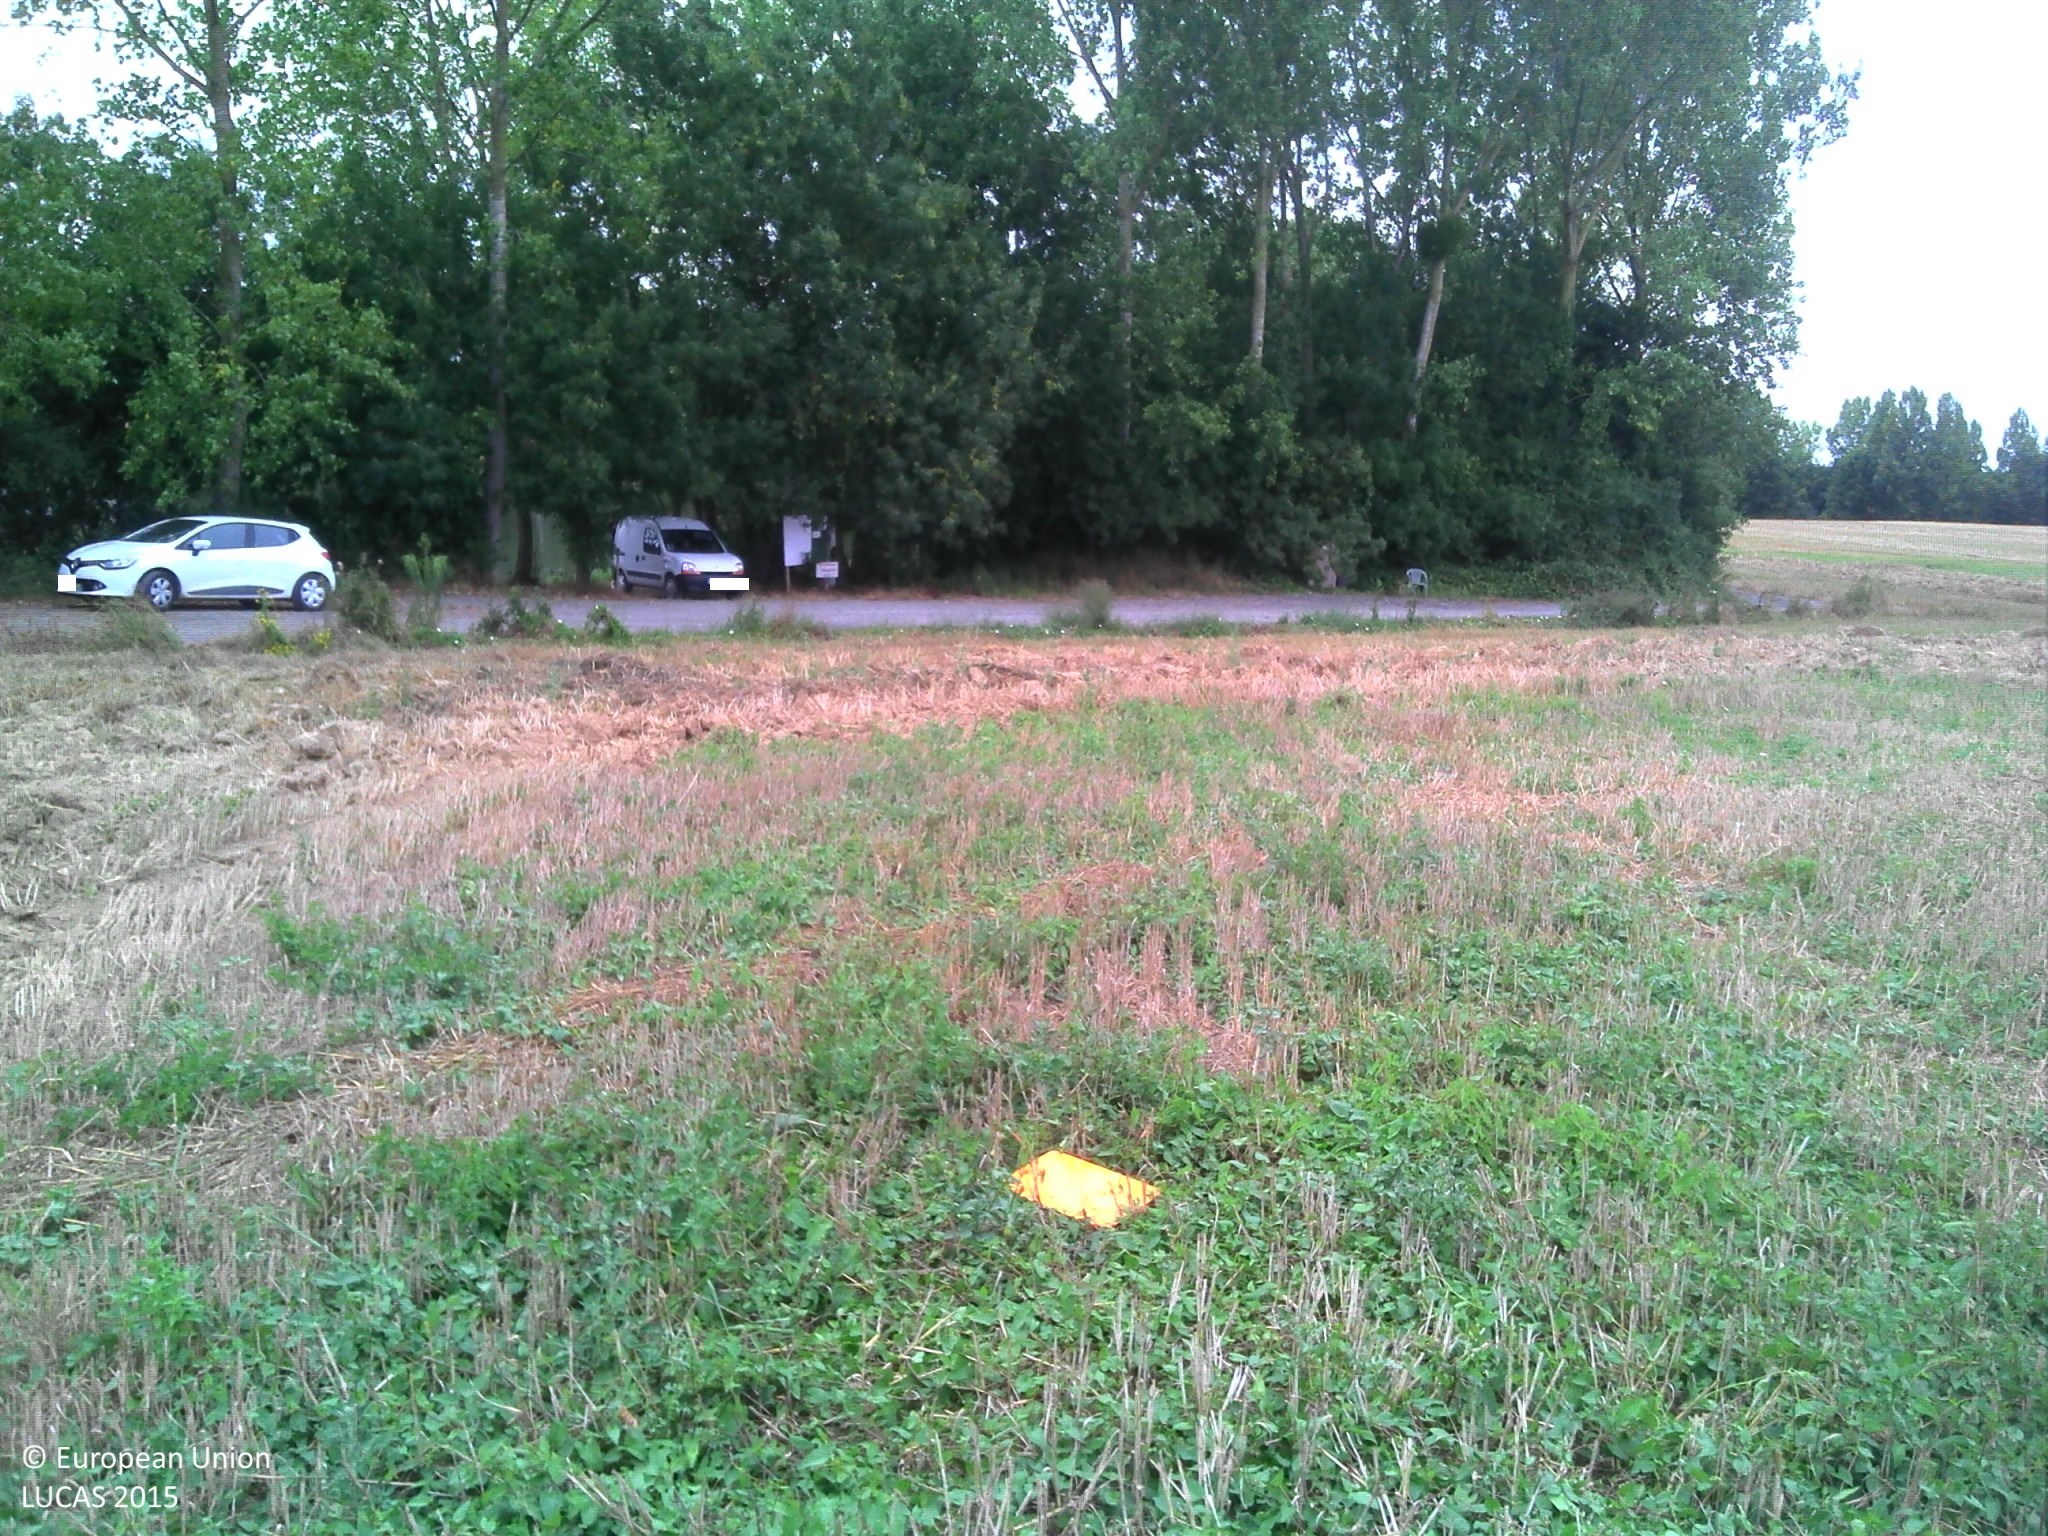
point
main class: Cropland
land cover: Common wheat
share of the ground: > 75 %
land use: Agriculture (excluding fallow land and kitchen gardens)
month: July
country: FR
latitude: 46.8093
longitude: -1.0816
